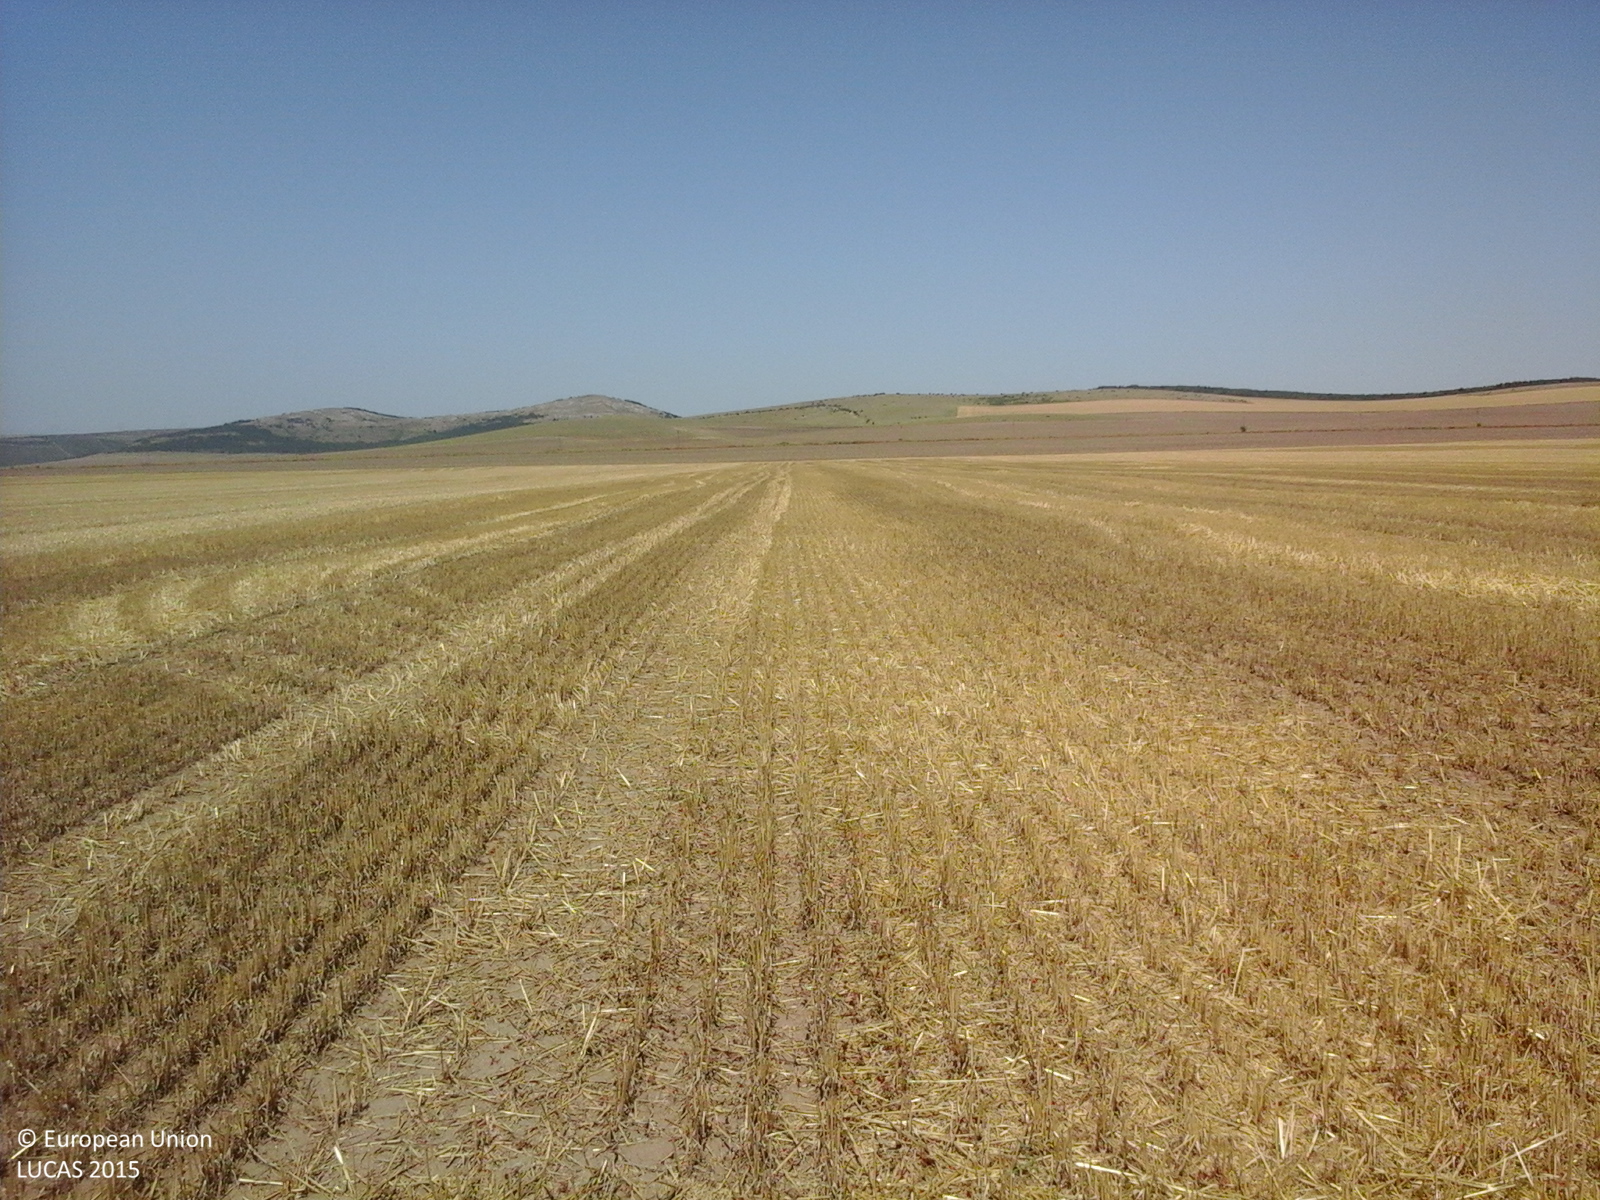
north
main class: Cropland
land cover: Common wheat
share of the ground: 50 - 75 %
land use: Agriculture (excluding fallow land and kitchen gardens)
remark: Harvested field
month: August
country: RO
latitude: 44.4721
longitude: 28.2292
